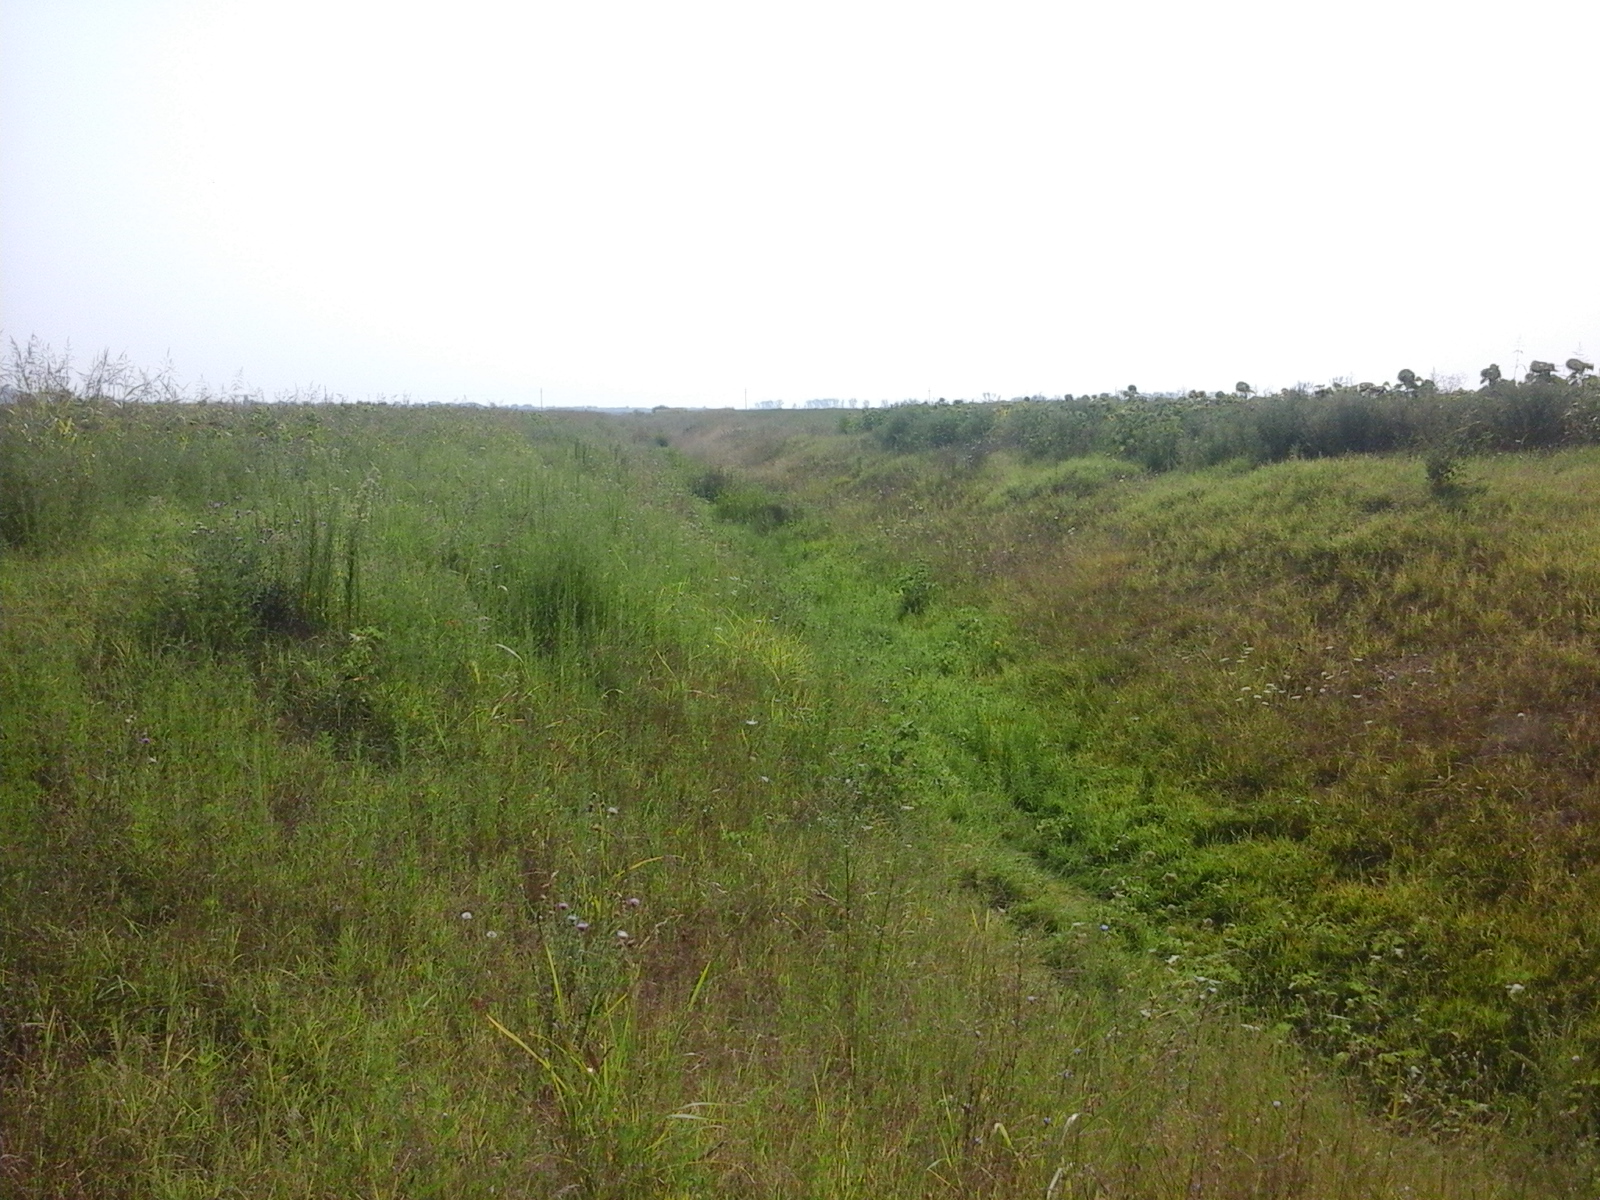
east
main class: Cropland
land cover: Sunflower
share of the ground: > 75 %
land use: Agriculture (excluding fallow land and kitchen gardens)
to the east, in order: Sunflower
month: August
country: RO
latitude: 44.0381
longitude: 23.4383
